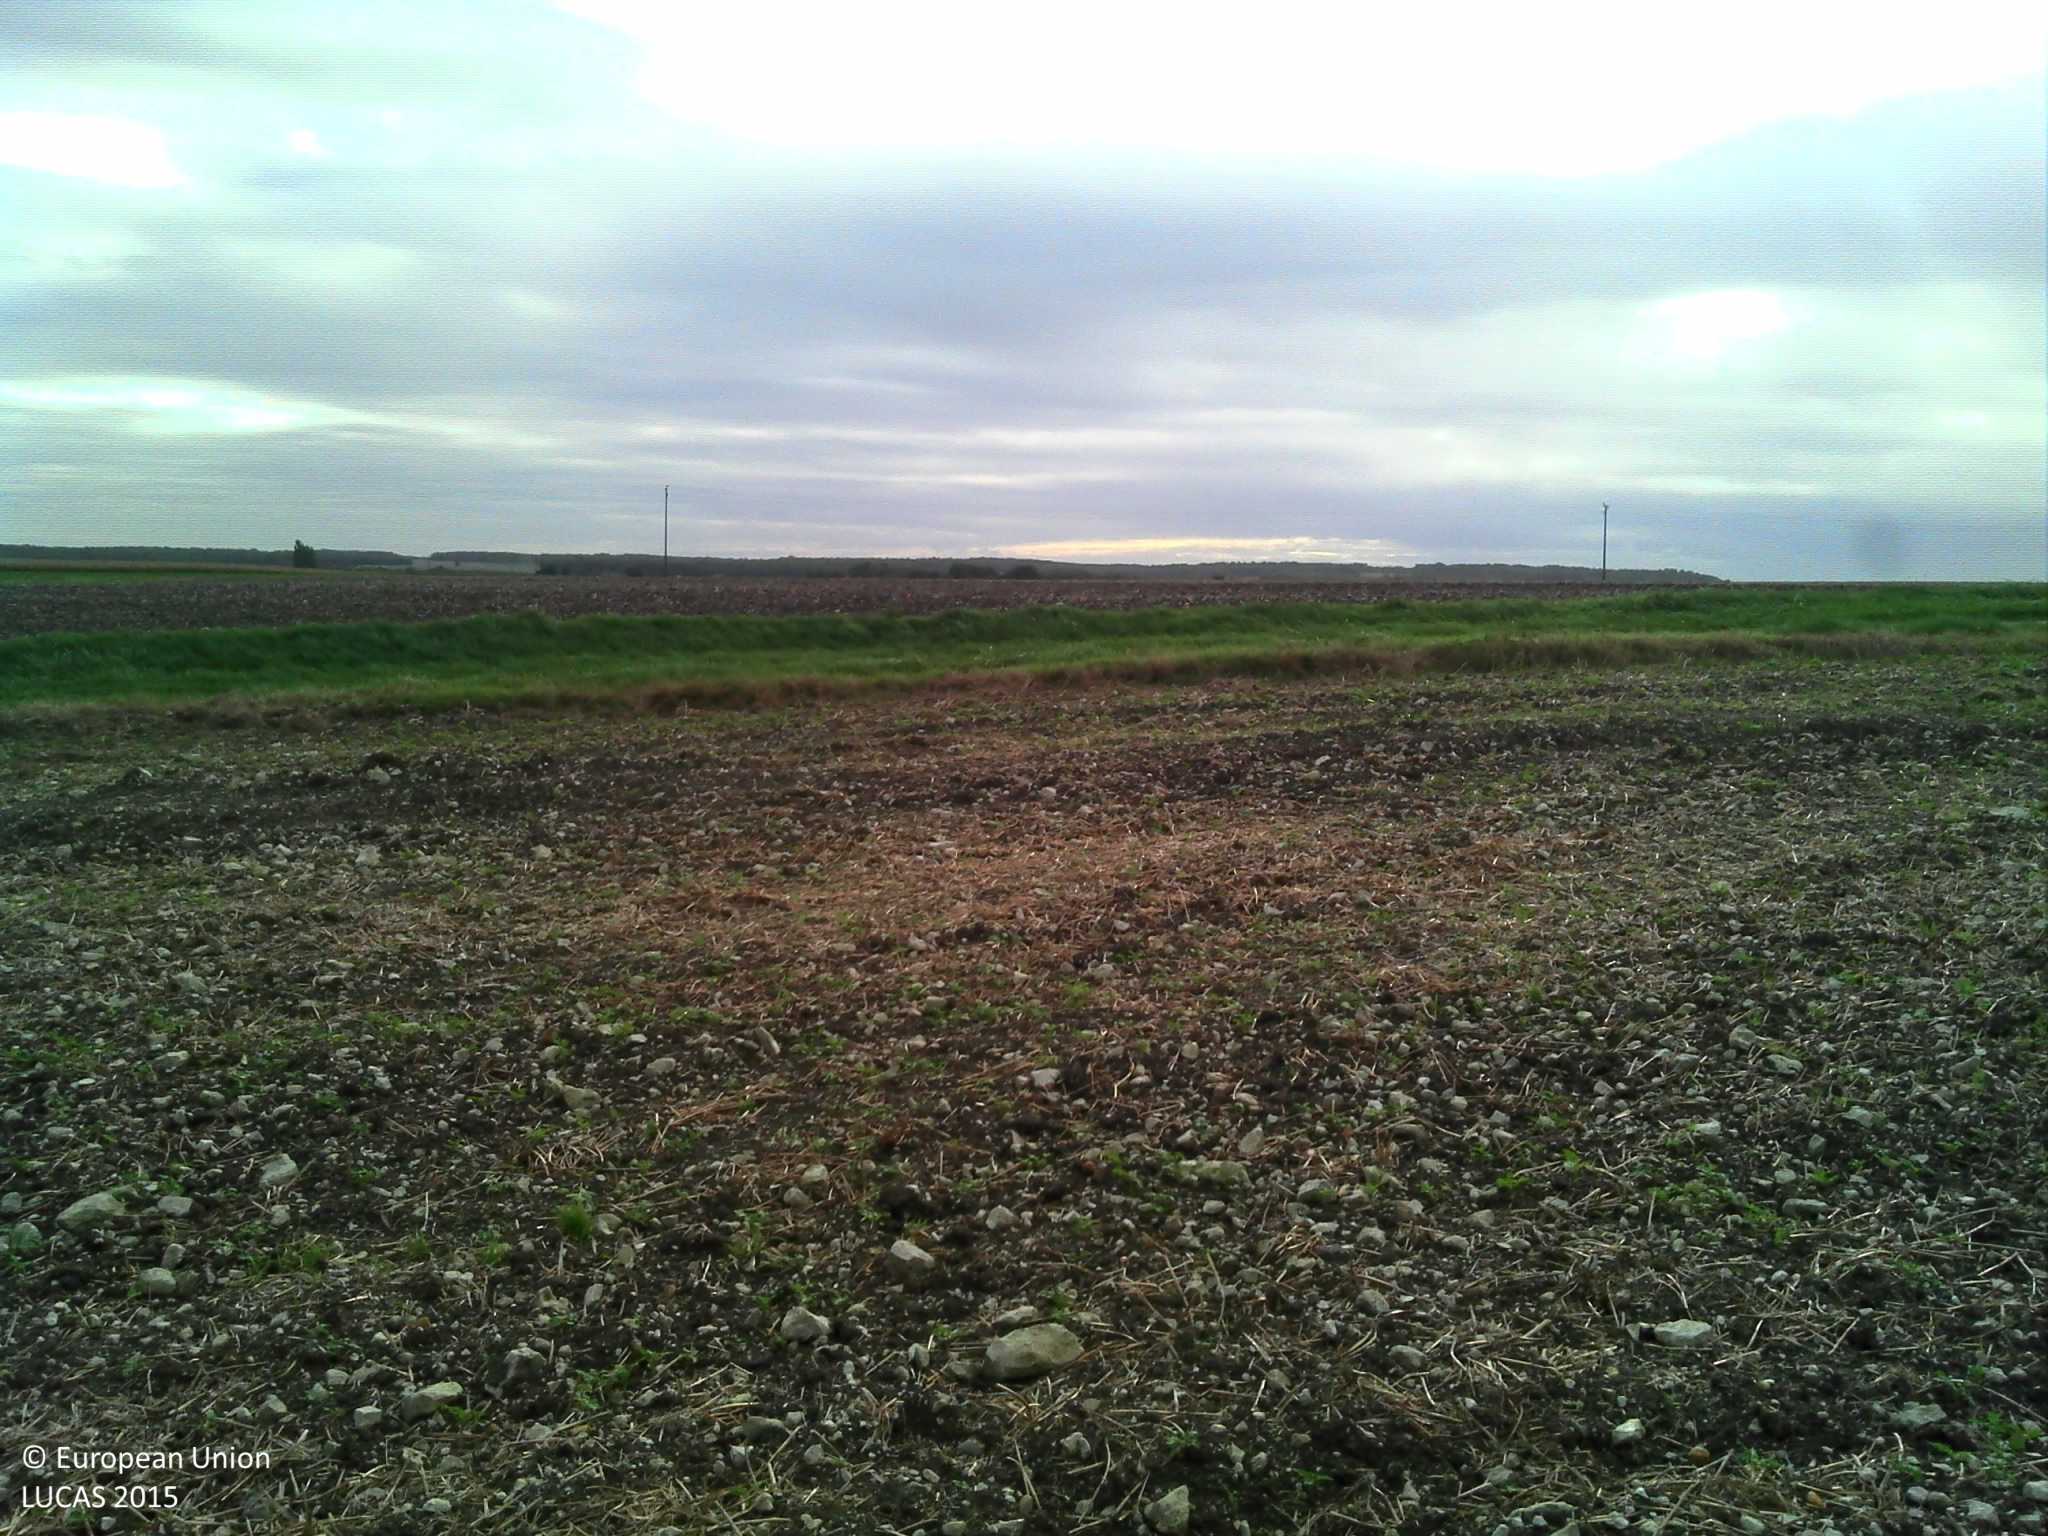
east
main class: Cropland
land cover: Barley
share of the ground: > 75 %
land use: Agriculture (excluding fallow land and kitchen gardens)
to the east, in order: Barley; Grass margins; Paved roads, cycling and walking lanes; Grass margins; Rape and turnip rape; Spontaneously vegetated surfaces; Electric lines; Spontaneously vegetated surfaces
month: October
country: FR
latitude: 47.0752
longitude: 0.5645
